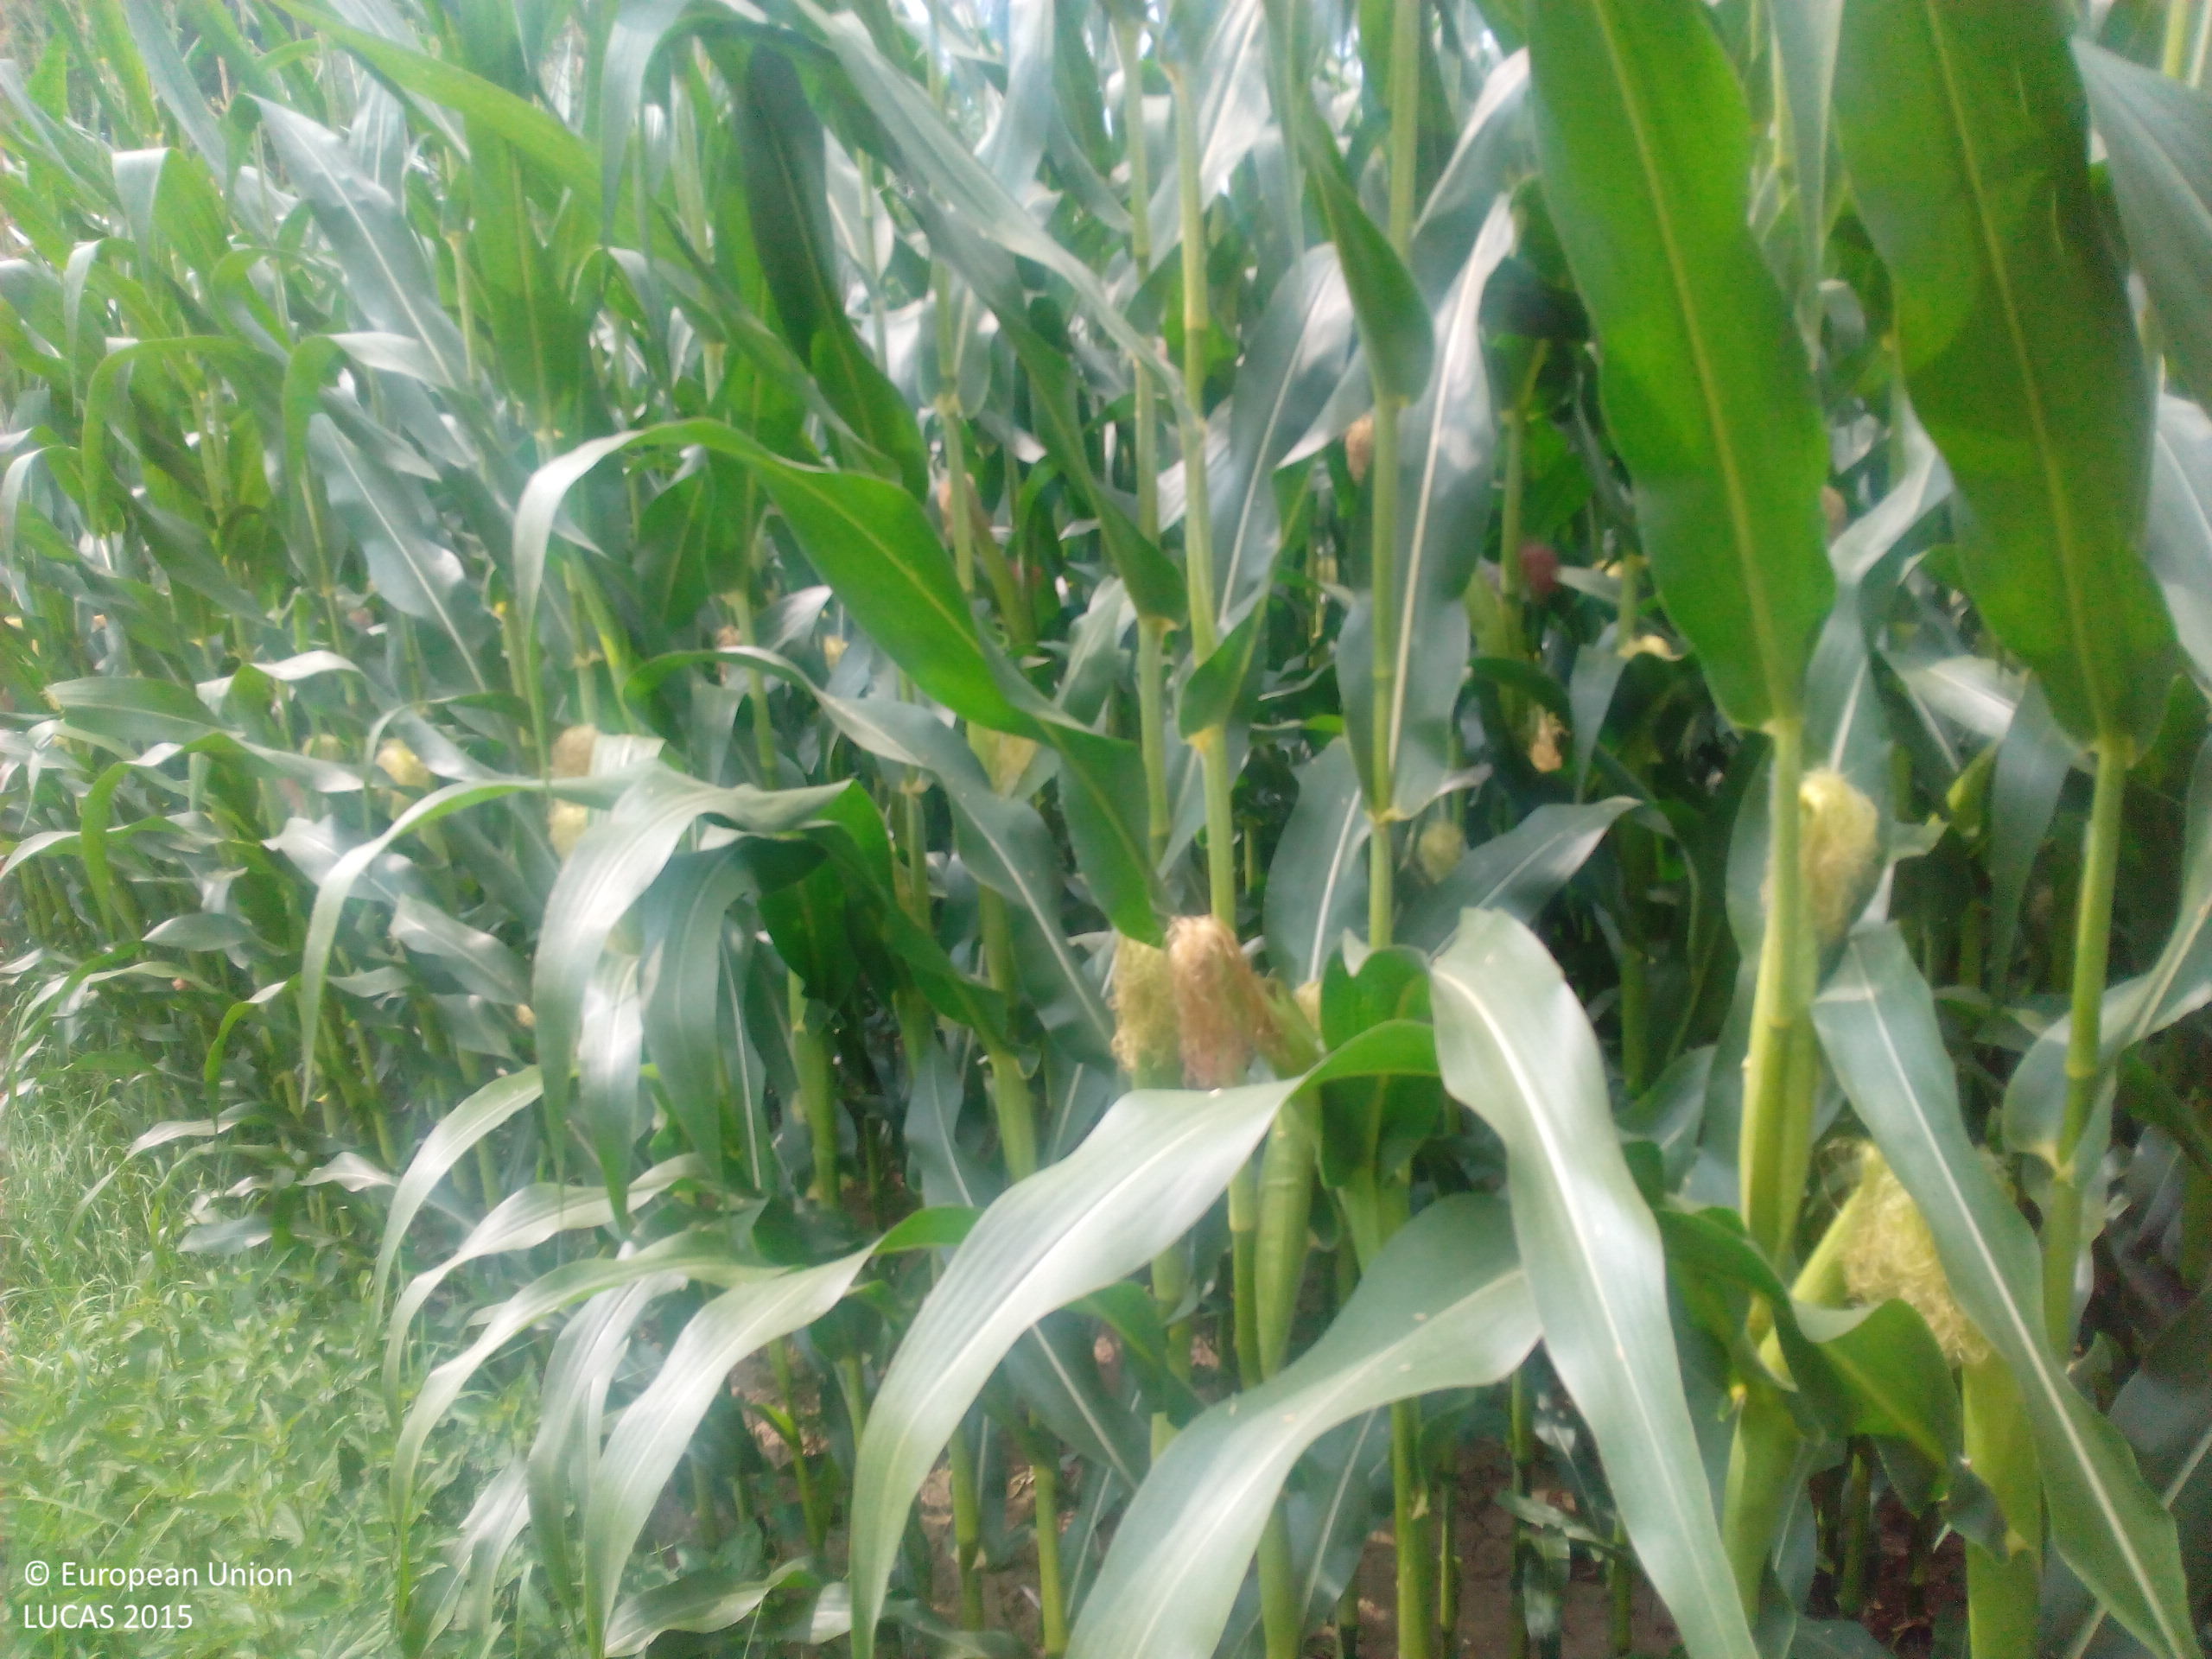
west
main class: Cropland
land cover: Maize
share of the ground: > 75 %
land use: Agriculture (excluding fallow land and kitchen gardens)
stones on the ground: < 10 %
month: July
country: DE
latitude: 48.4104
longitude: 13.2282
